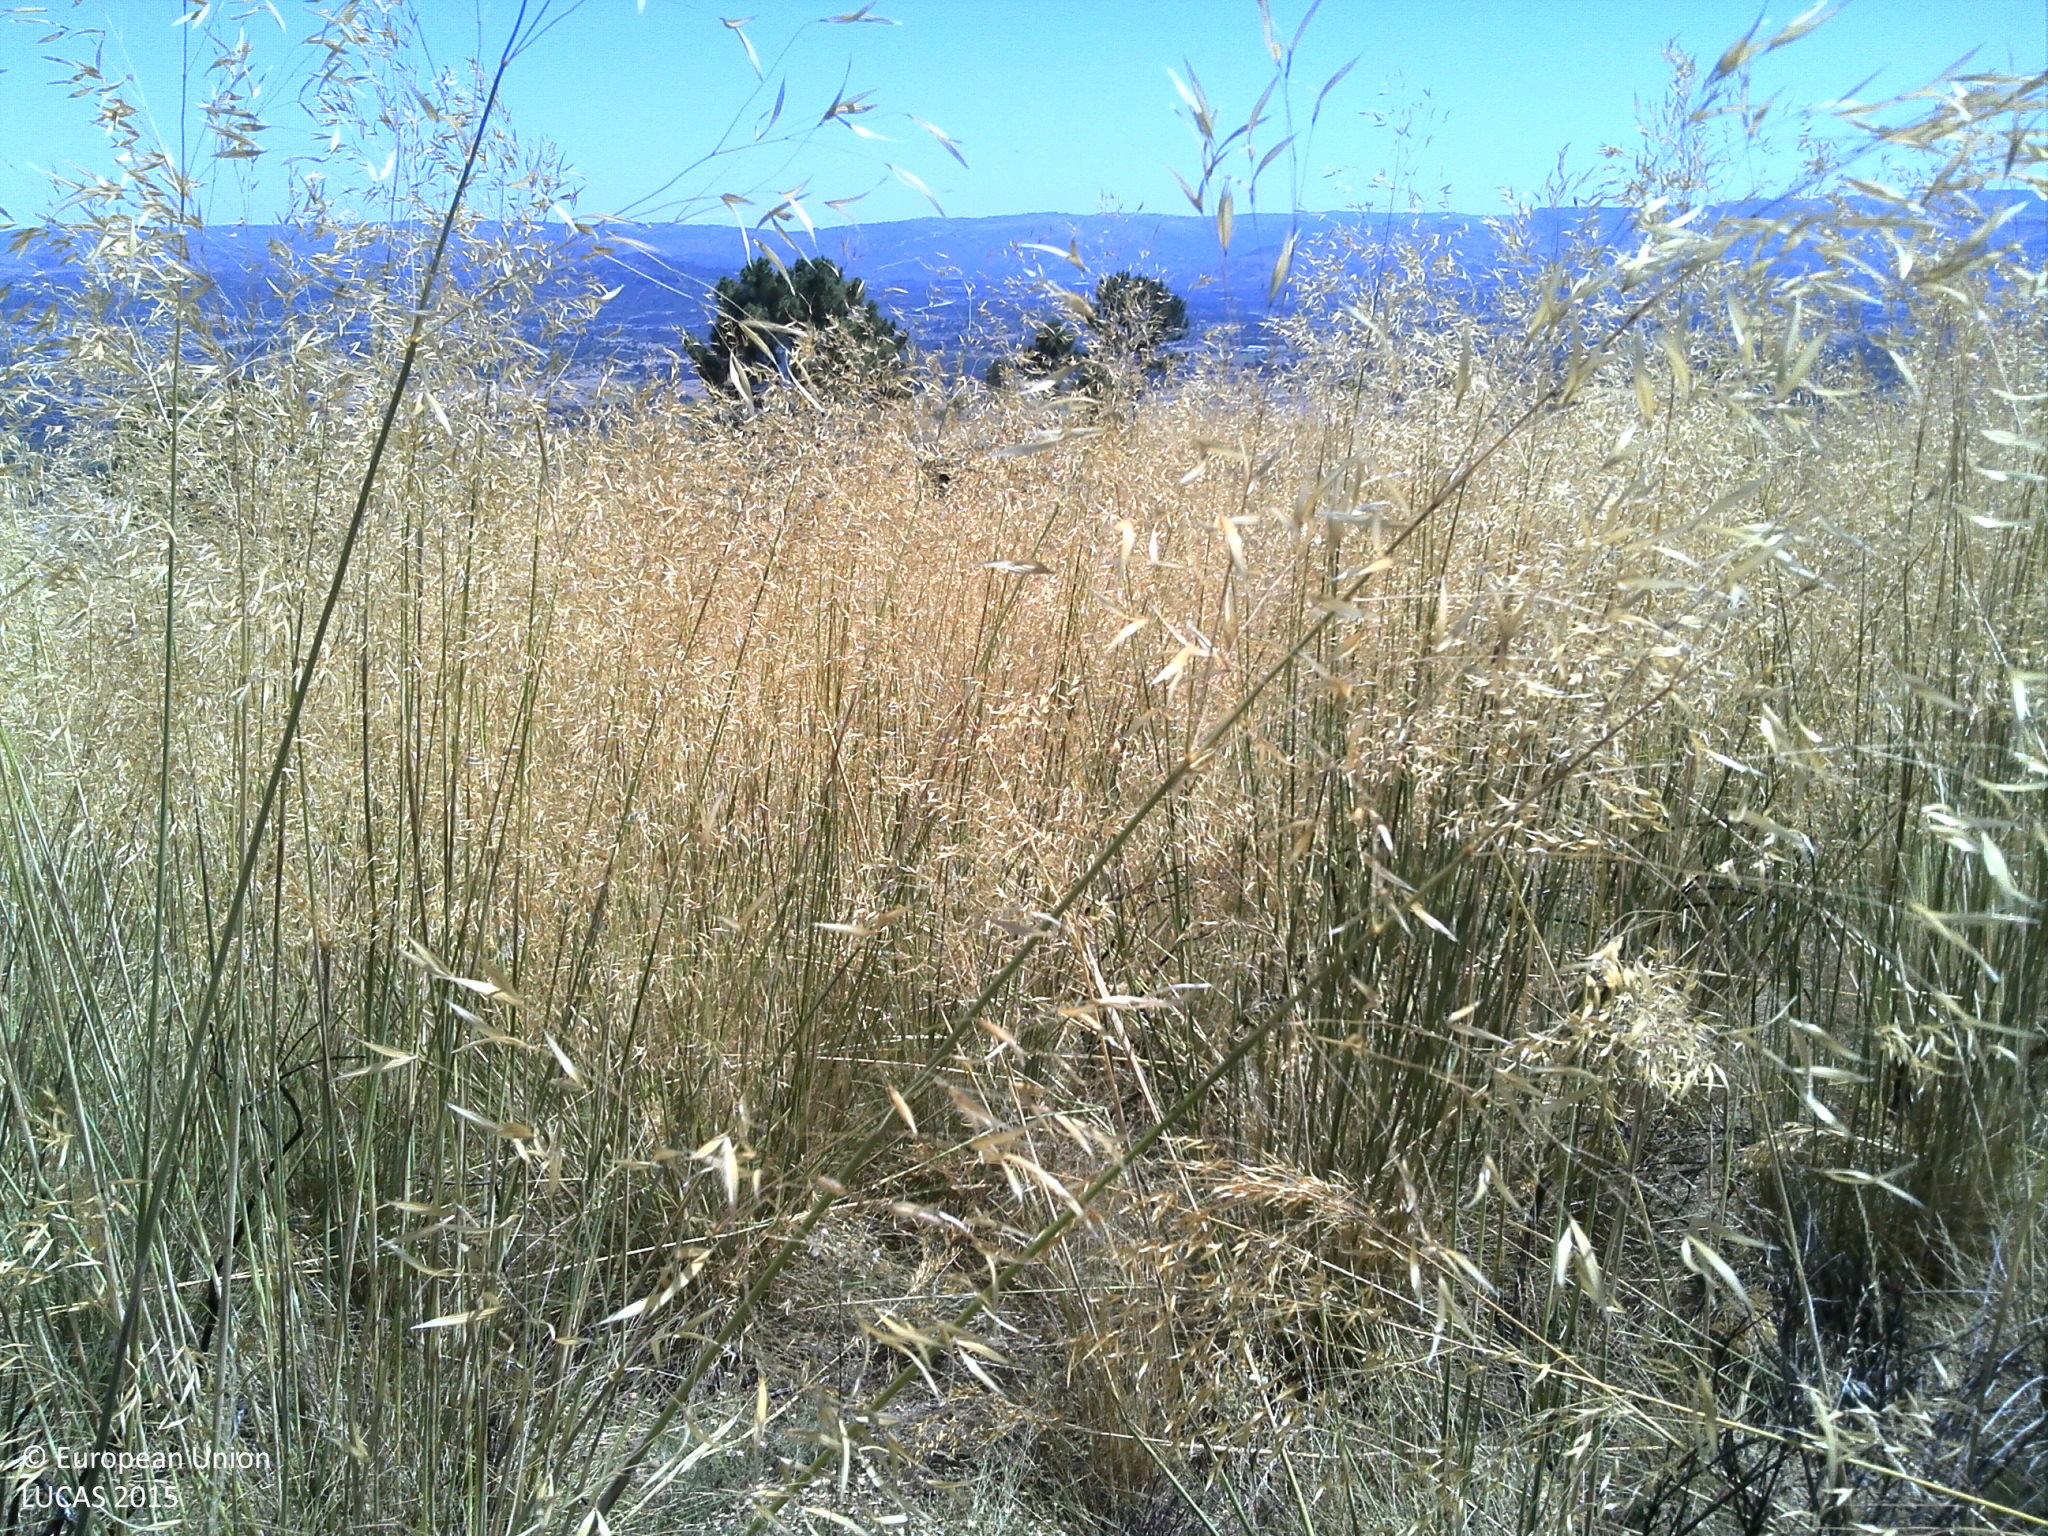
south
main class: Grassland
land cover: Spontaneously vegetated surfaces
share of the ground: 50 - 75 %
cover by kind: herbaceous plants 60 %, unconsolidated bare surface 40 %
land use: Semi-natural and natural areas not in use
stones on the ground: 10 - 25 %
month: June
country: PT
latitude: 40.7350
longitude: -7.3641
